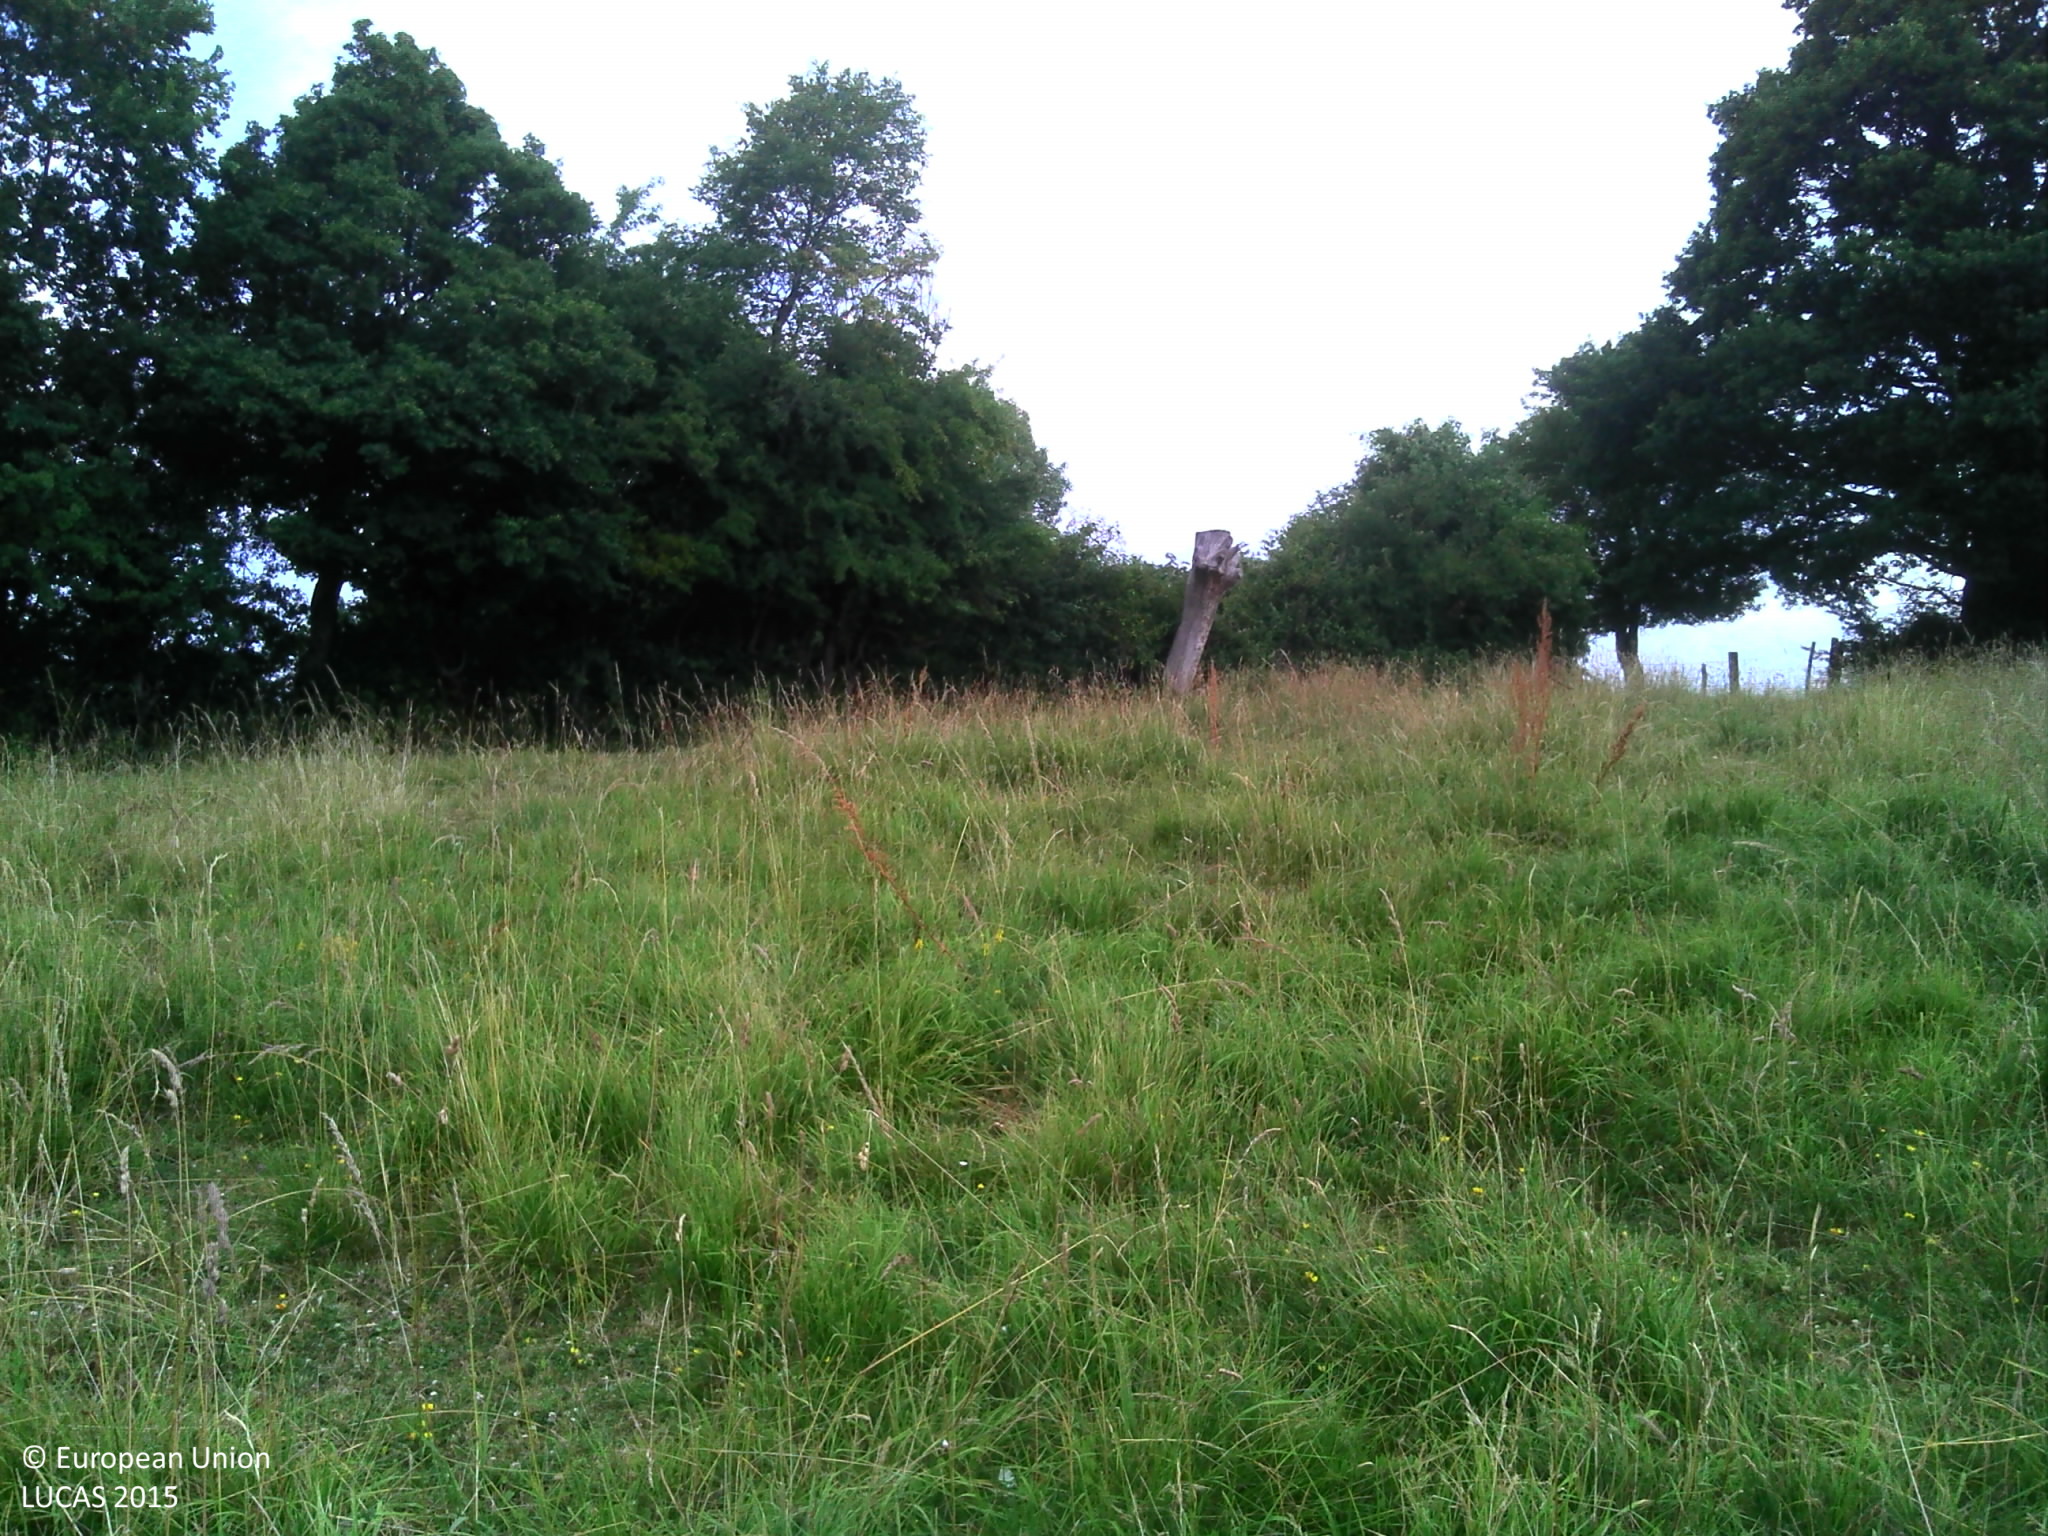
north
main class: Grassland
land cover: Grassland without tree/shrub cover
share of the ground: > 75 %
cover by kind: herbaceous plants 100 %
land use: Agriculture (excluding fallow land and kitchen gardens)
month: July
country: FR
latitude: 49.0033
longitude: 0.0317
